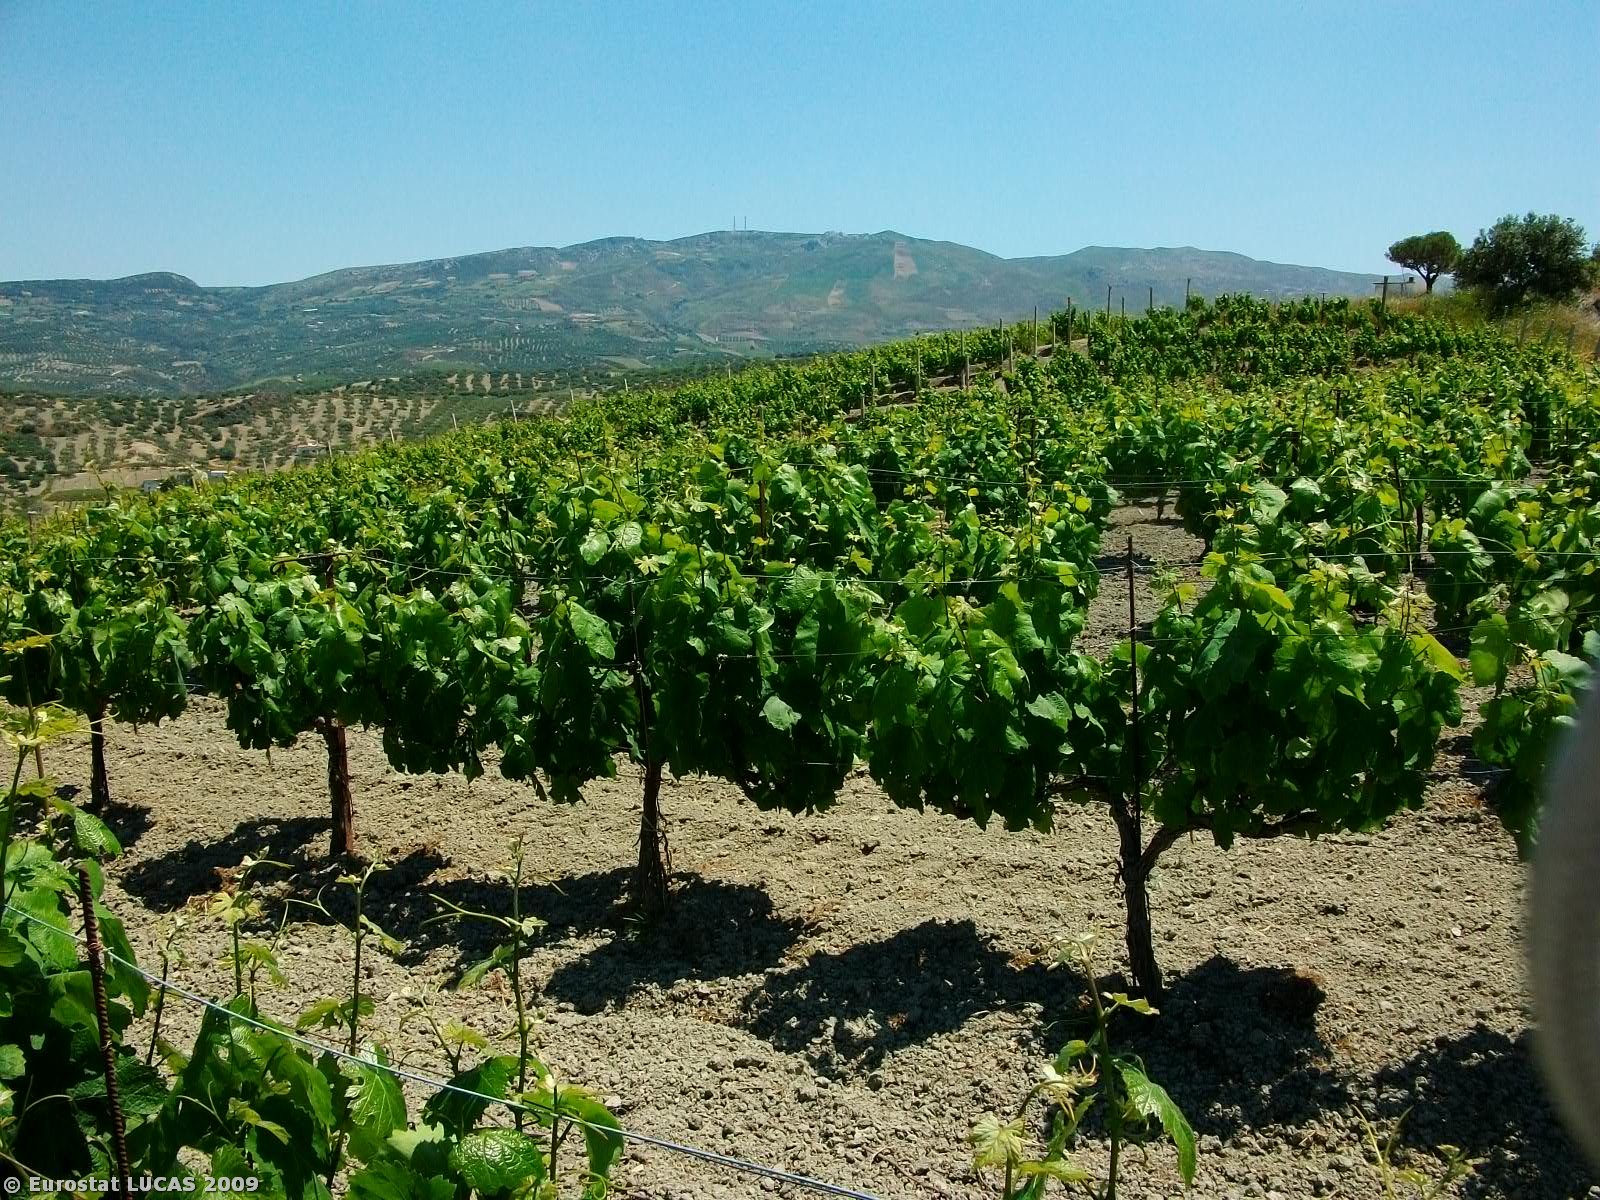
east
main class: Cropland
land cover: Vineyards
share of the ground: 25 - 50 %
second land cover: Bare land
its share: > 75 %
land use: Agriculture (excluding fallow land and kitchen gardens)
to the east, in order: Vineyards; Bare land; Tracks; Vineyards; Bare land; Tracks; Vineyards; Bare land; Single bushes/trees; Tracks; Grassland without tree/shrub cover; Vineyards; Bare land; Tracks; Vineyards; Bare land
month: May
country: GR
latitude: 35.1834
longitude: 25.1334
